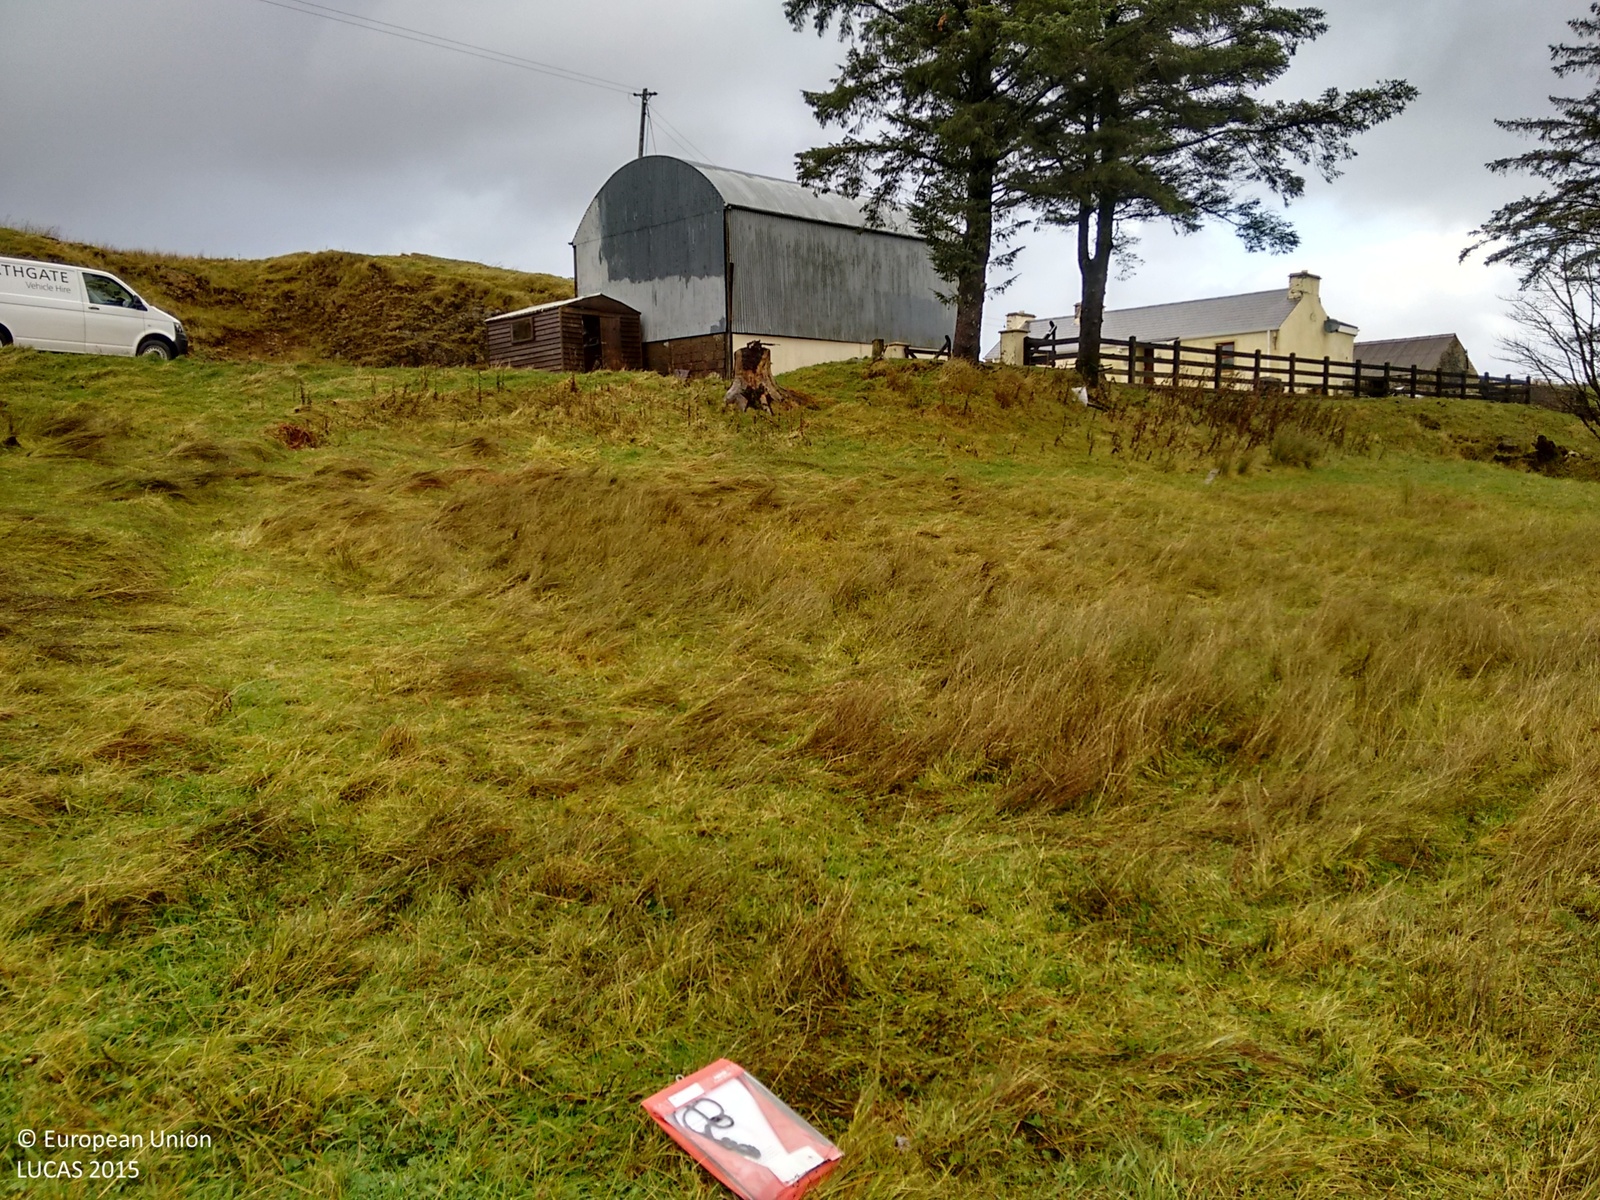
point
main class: Grassland
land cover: Grassland without tree/shrub cover
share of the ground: > 75 %
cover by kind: herbaceous plants 100 %
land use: Agriculture (excluding fallow land and kitchen gardens)
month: November
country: IE
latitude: 54.7238
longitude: -8.3025
